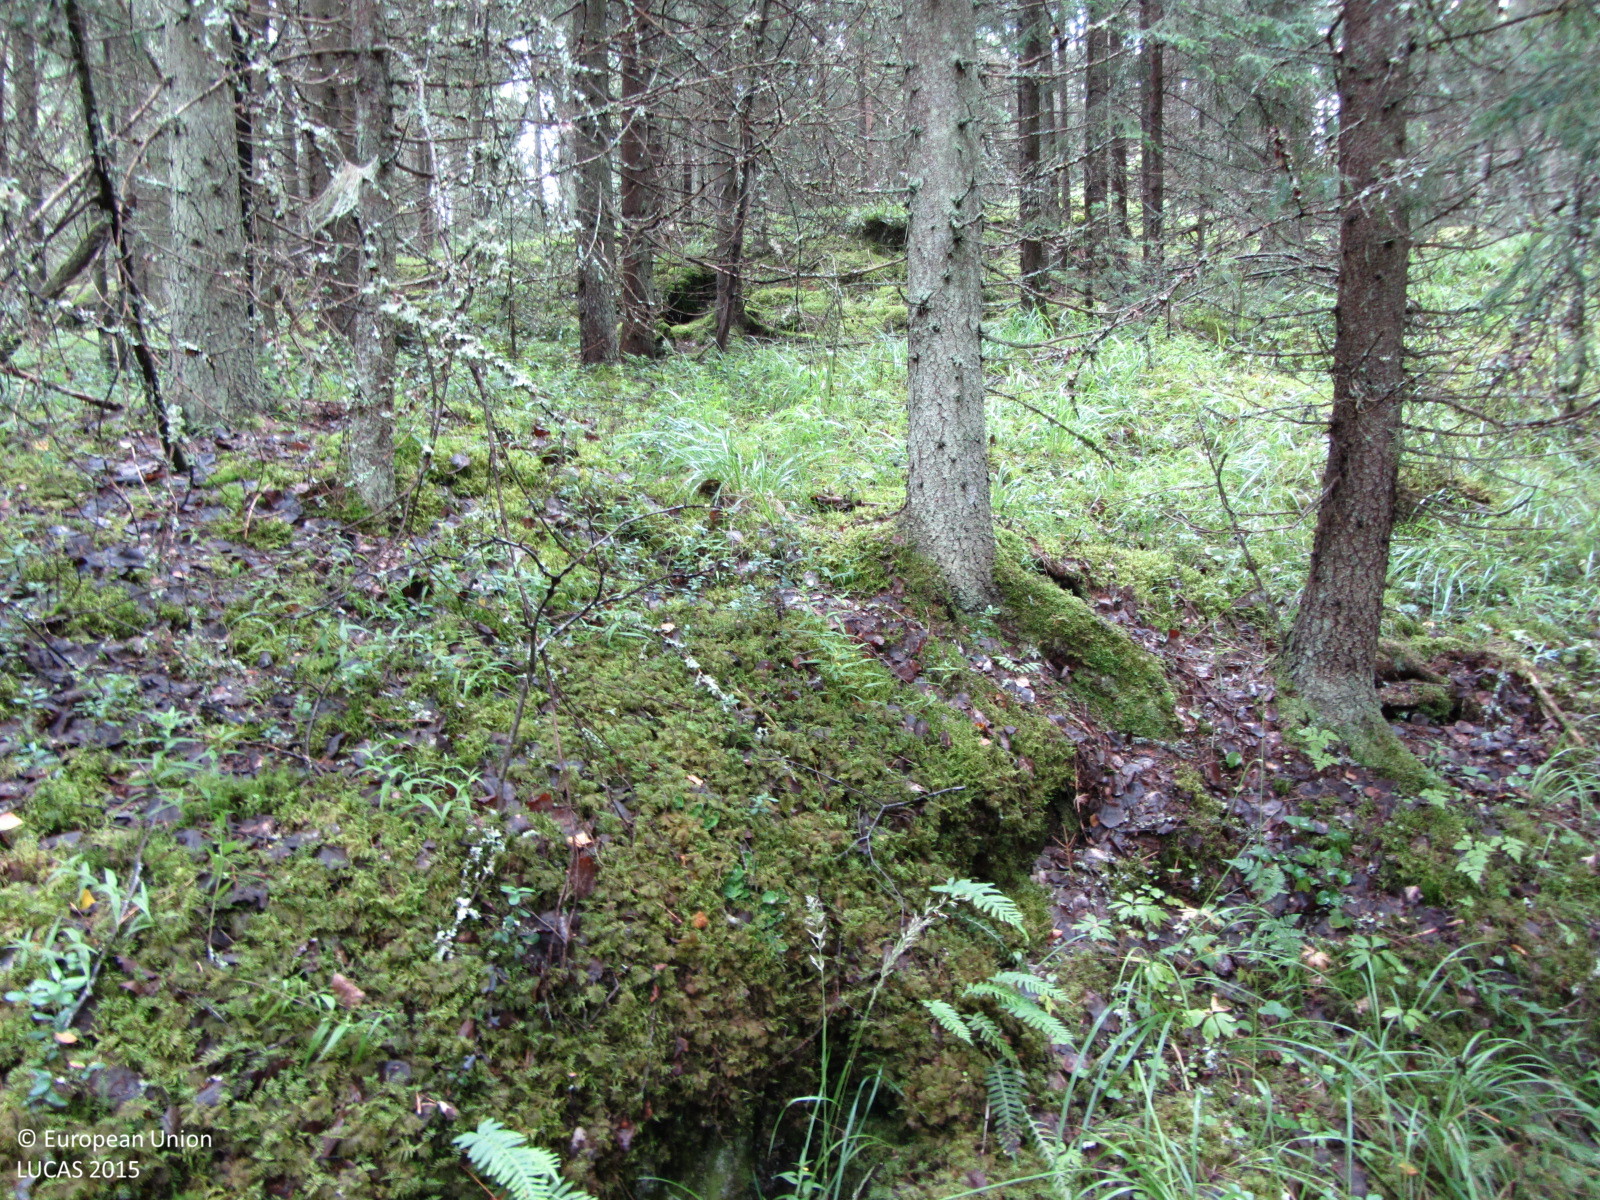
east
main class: Woodland
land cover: Spruce dominated mixed woodland
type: boreal forest
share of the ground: > 75 %
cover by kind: coniferous forest trees 60 %, broadleaved forest trees 20 %, lichens and mosses 10 %, shrubs 5 %, herbaceous plants 5 %
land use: Forestry
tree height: > 5 m
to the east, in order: Spruce dominated mixed woodland
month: July
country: FI
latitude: 60.4870
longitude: 24.3525
